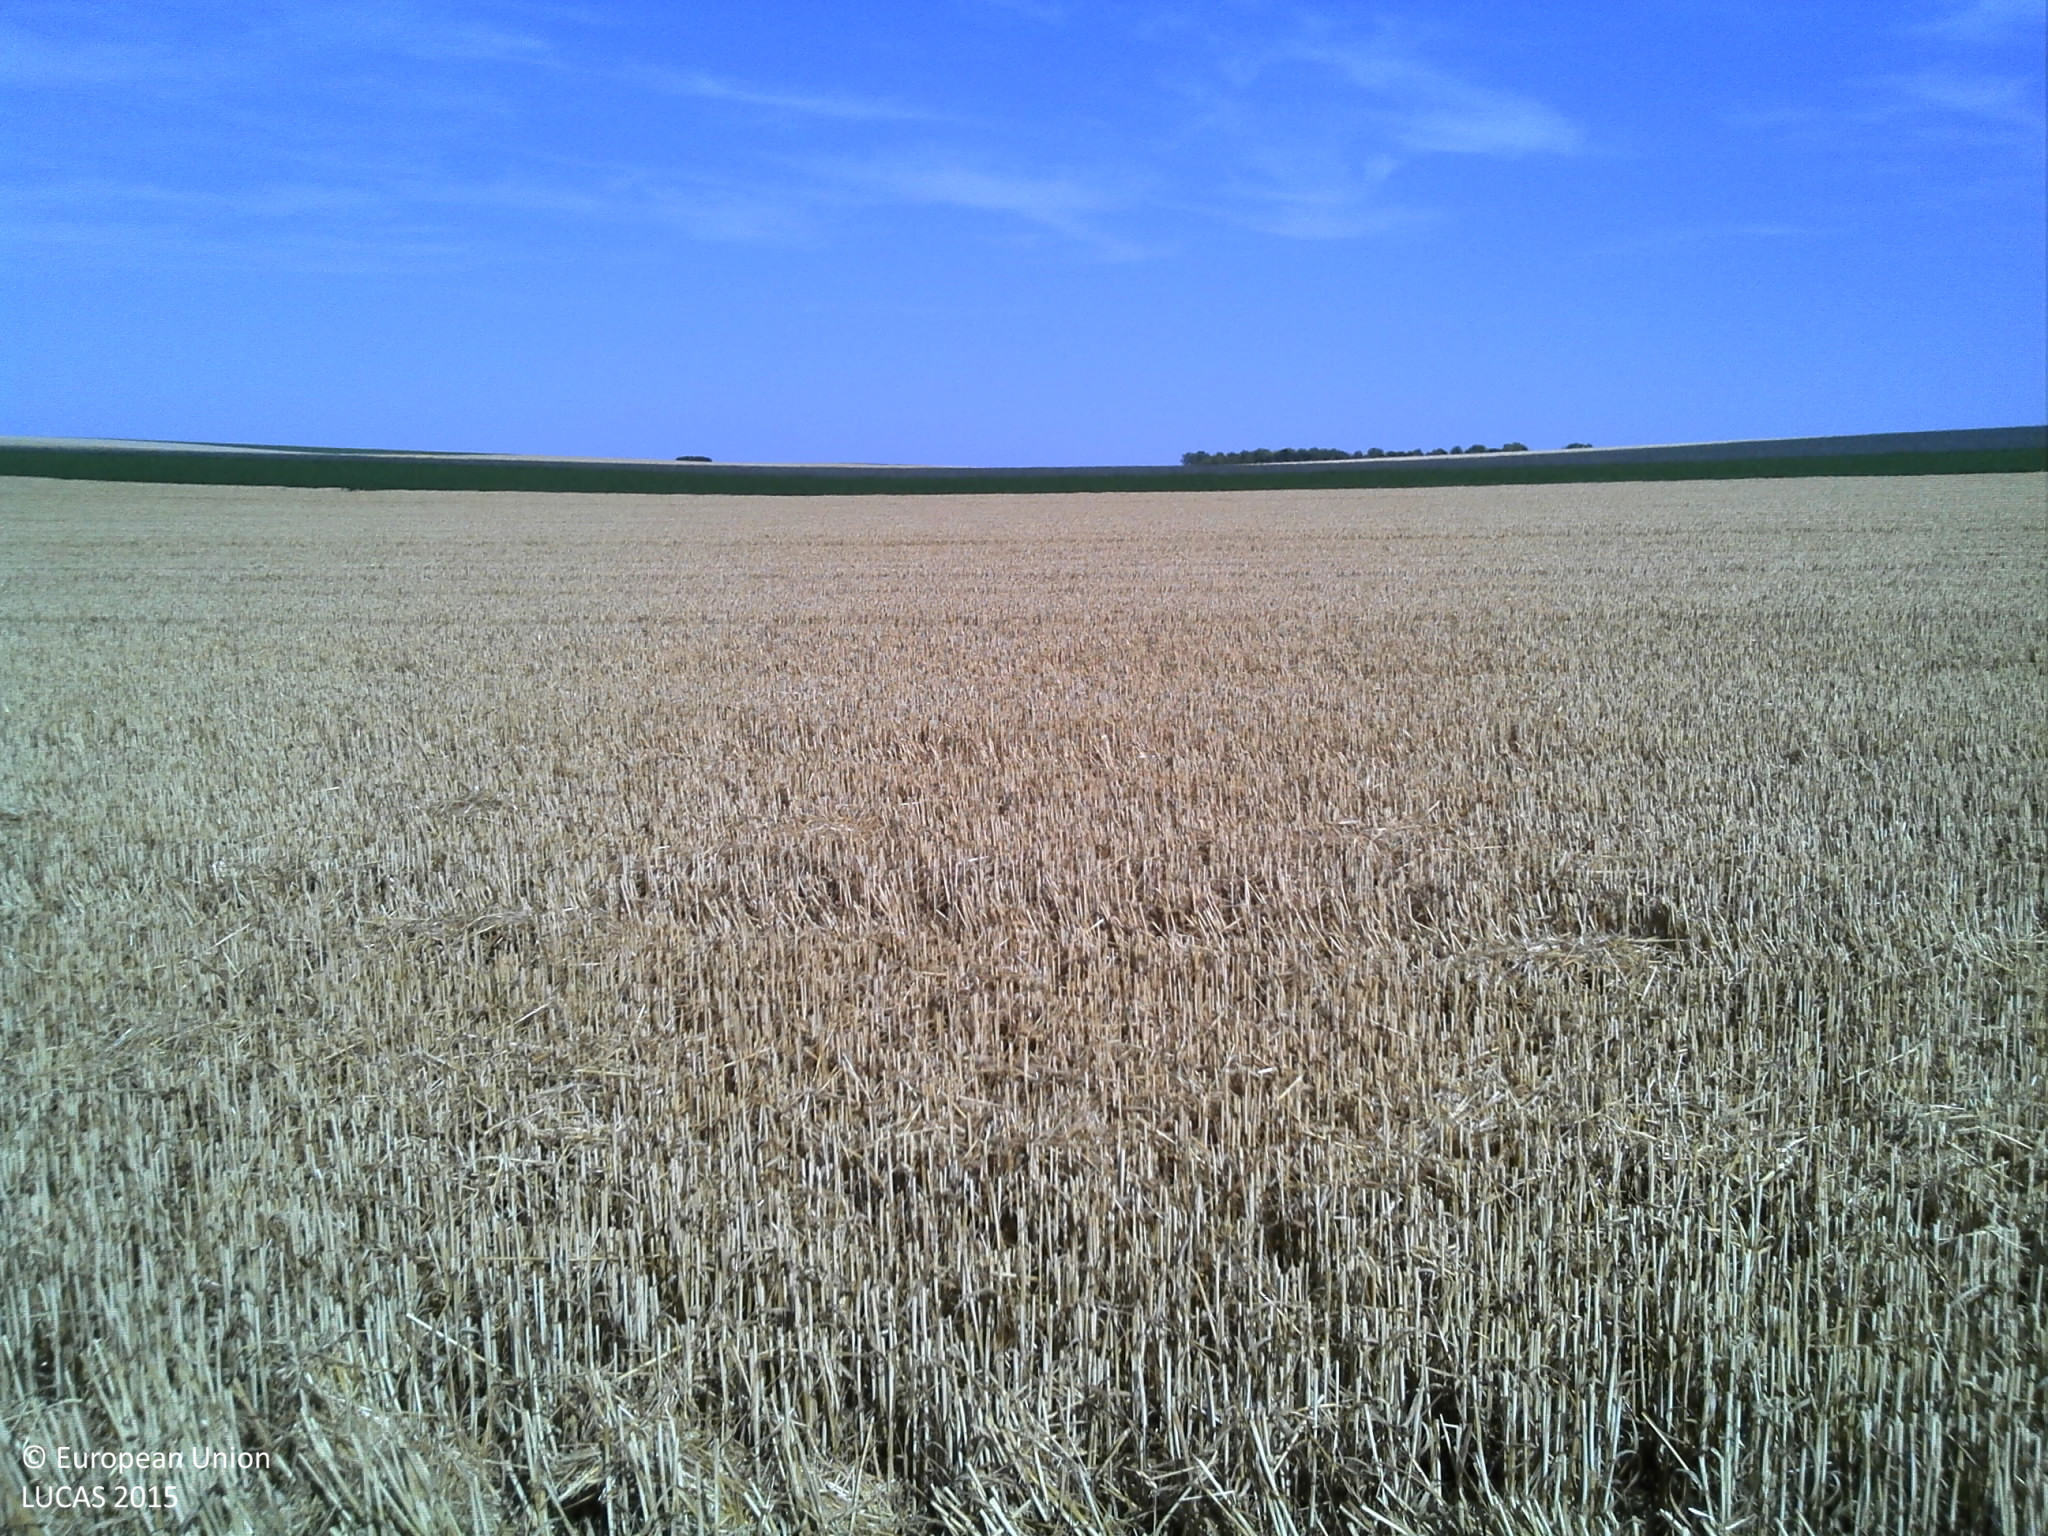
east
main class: Cropland
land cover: Common wheat
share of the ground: > 75 %
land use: Agriculture (excluding fallow land and kitchen gardens)
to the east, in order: Common wheat; Lucerne; Other bare soil
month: August
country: FR
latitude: 49.1235
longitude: 4.6941
